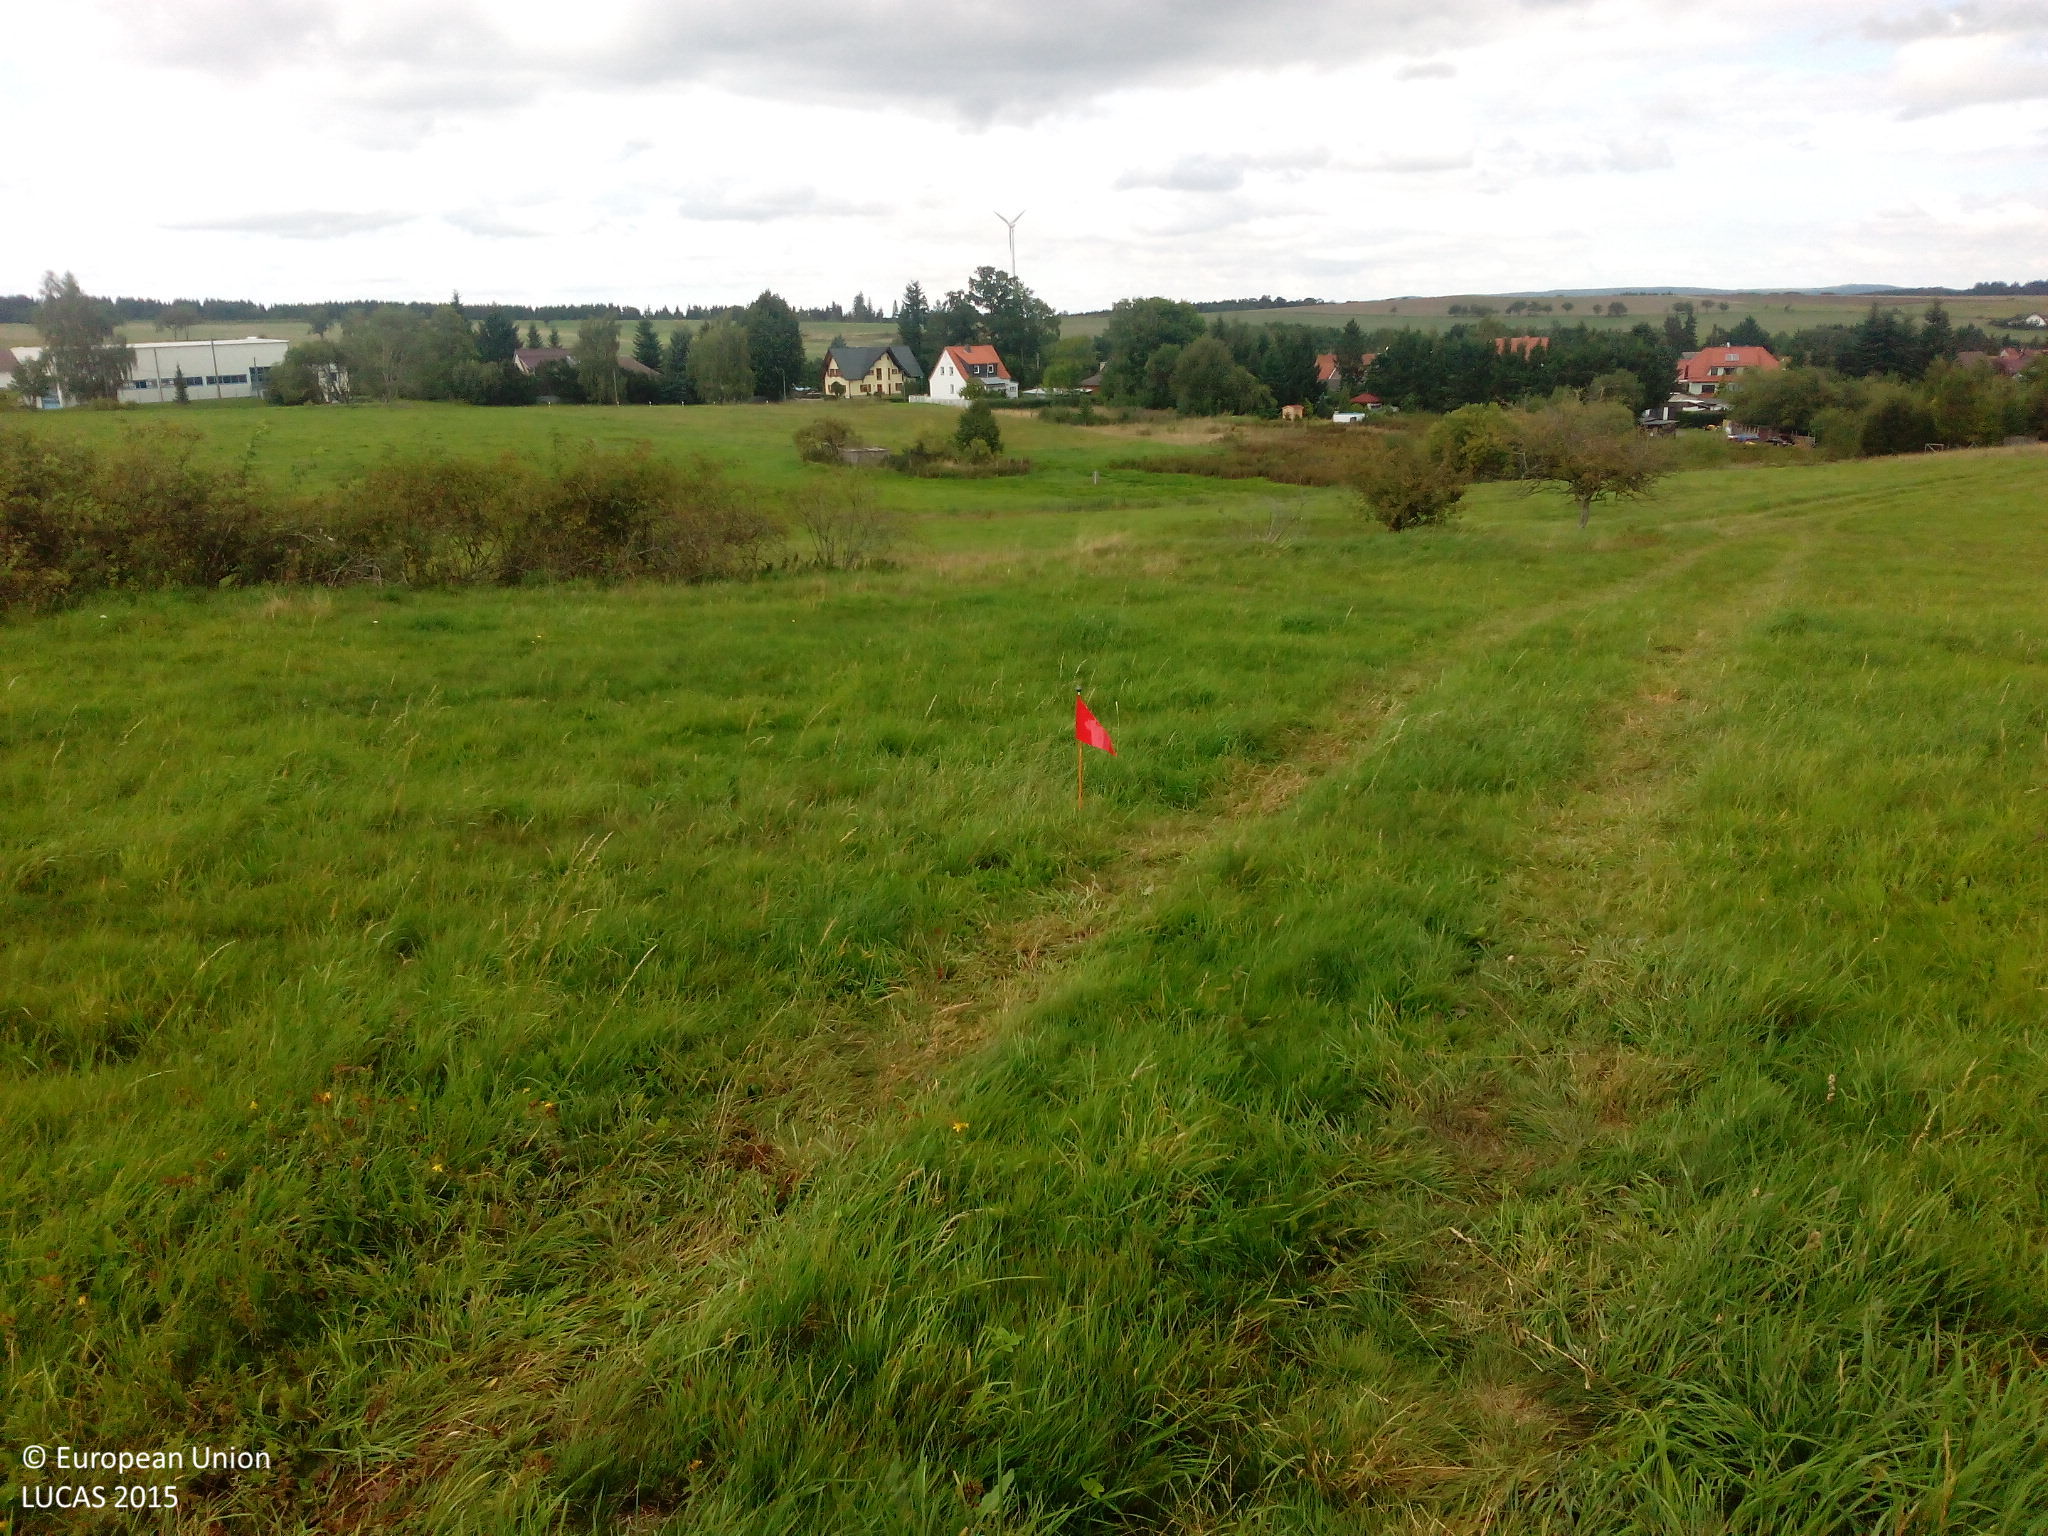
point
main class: Grassland
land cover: Grassland without tree/shrub cover
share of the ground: > 75 %
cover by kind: herbaceous plants 100 %
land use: Agriculture (excluding fallow land and kitchen gardens)
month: September
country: DE
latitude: 51.6188
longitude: 10.9385
